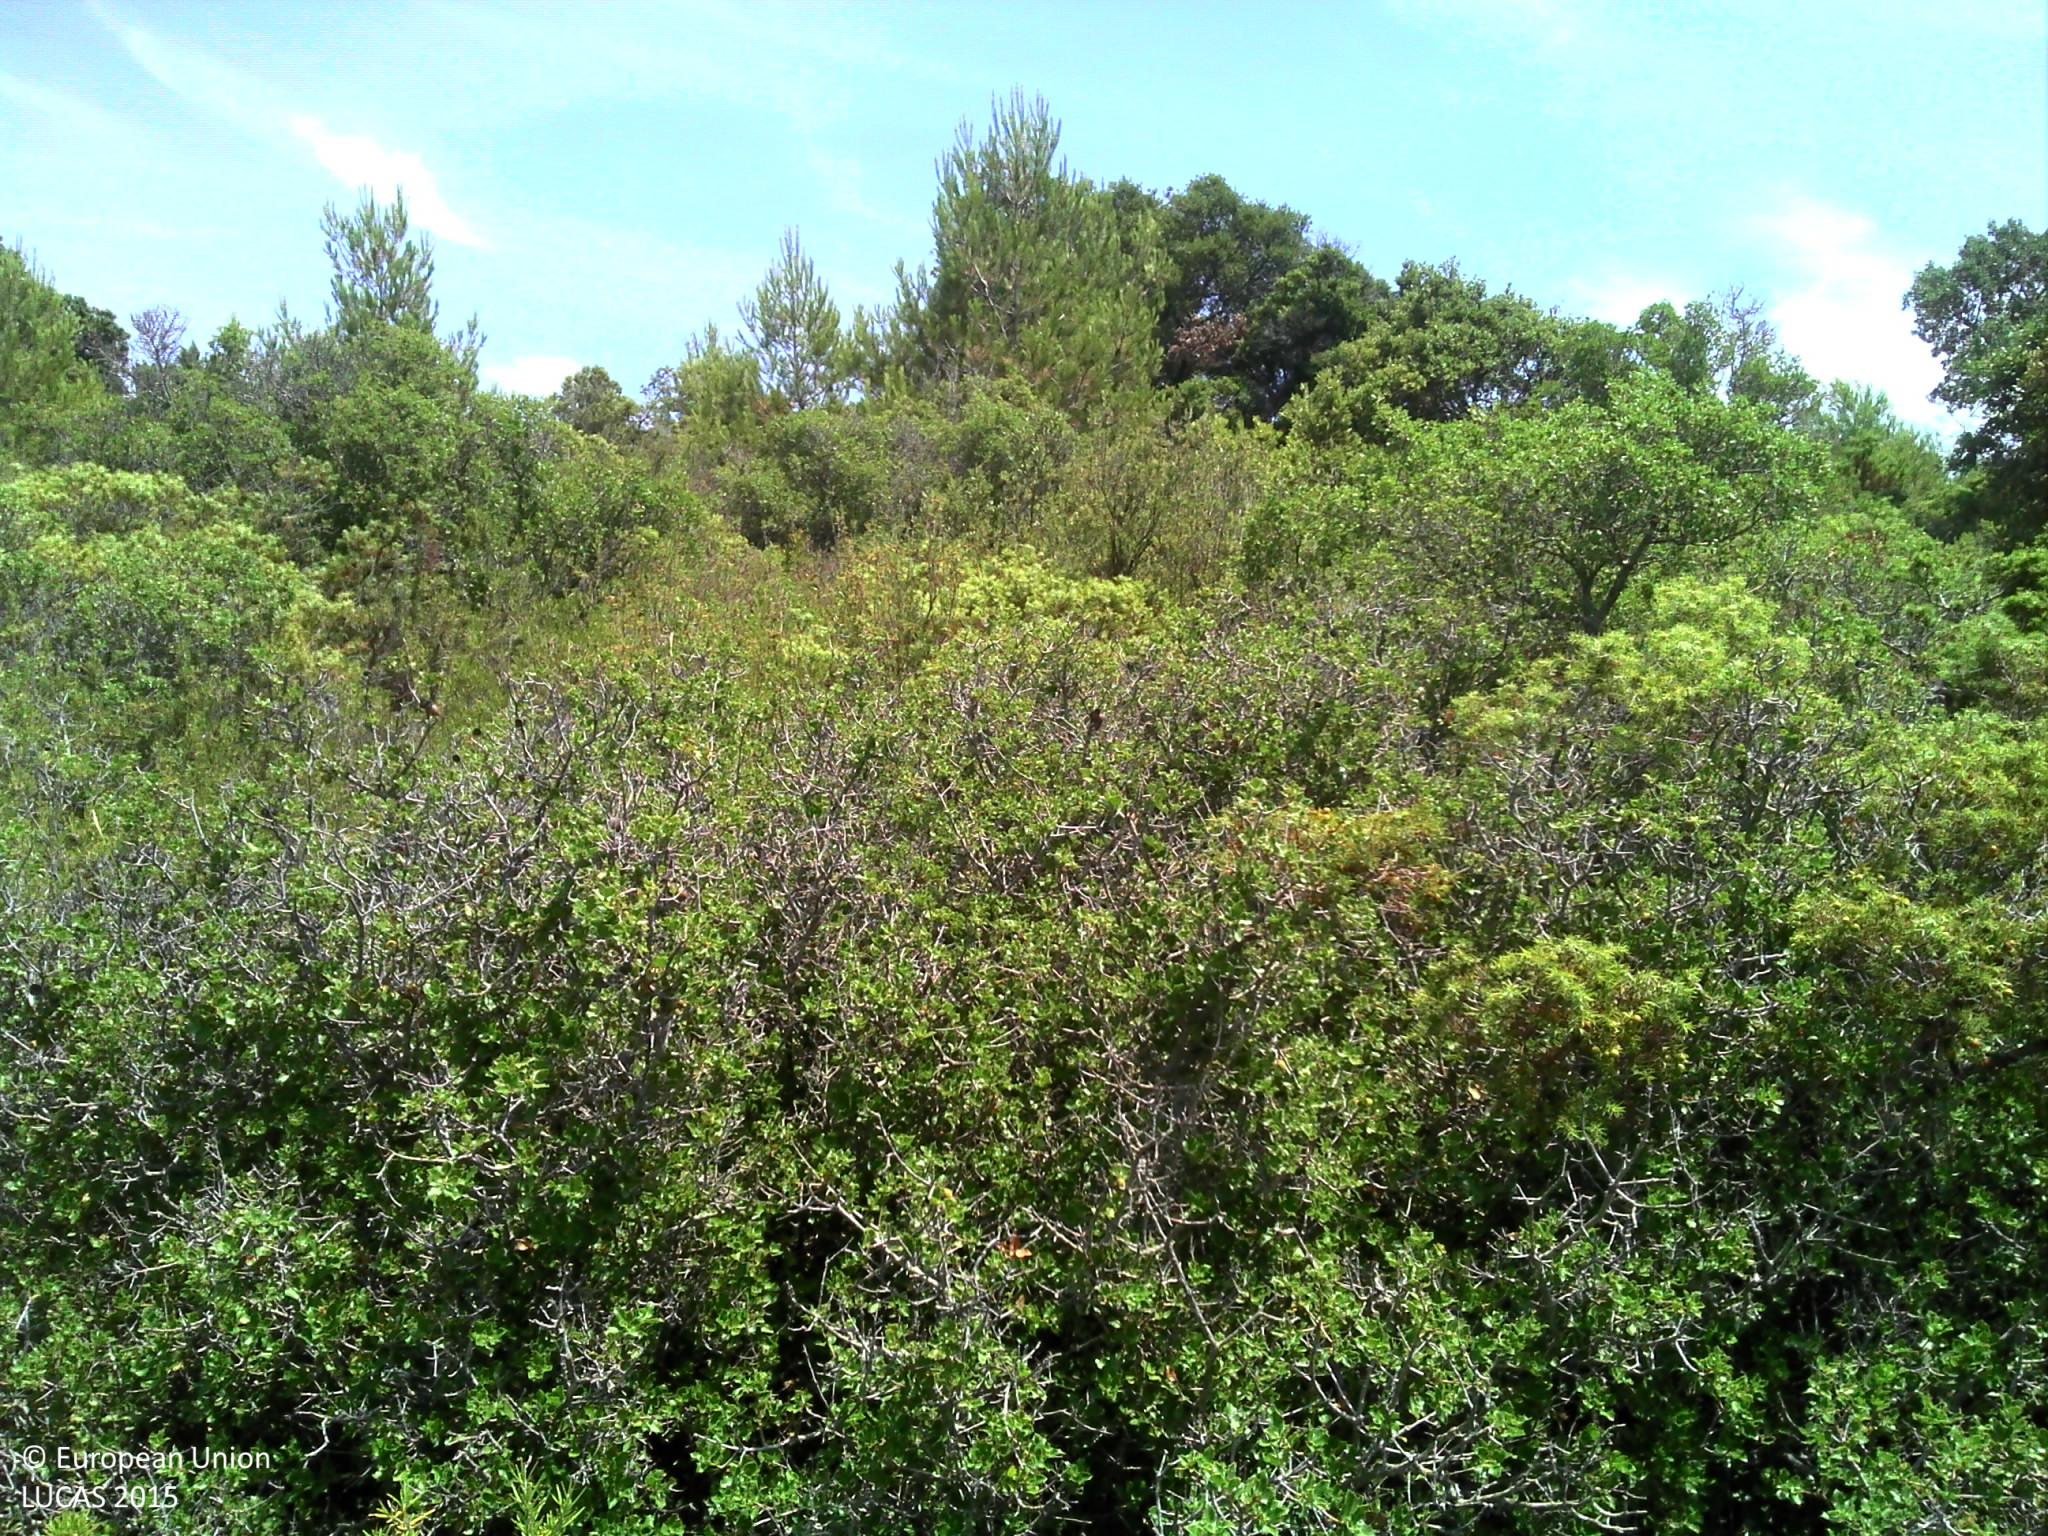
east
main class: Shrubland
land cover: Shrubland with sparse tree cover
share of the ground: > 75 %
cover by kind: shrubs 95 %, broadleaved forest trees 5 %
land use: Semi-natural and natural areas not in use
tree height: < 5 m
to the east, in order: Shrubland with sparse tree cover; Ditches and canals; Grass margins; Paved roads, cycling and walking lanes; Grass margins; Electric lines; Shrubland with sparse tree cover
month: July
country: FR
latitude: 43.0450
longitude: 2.7304
